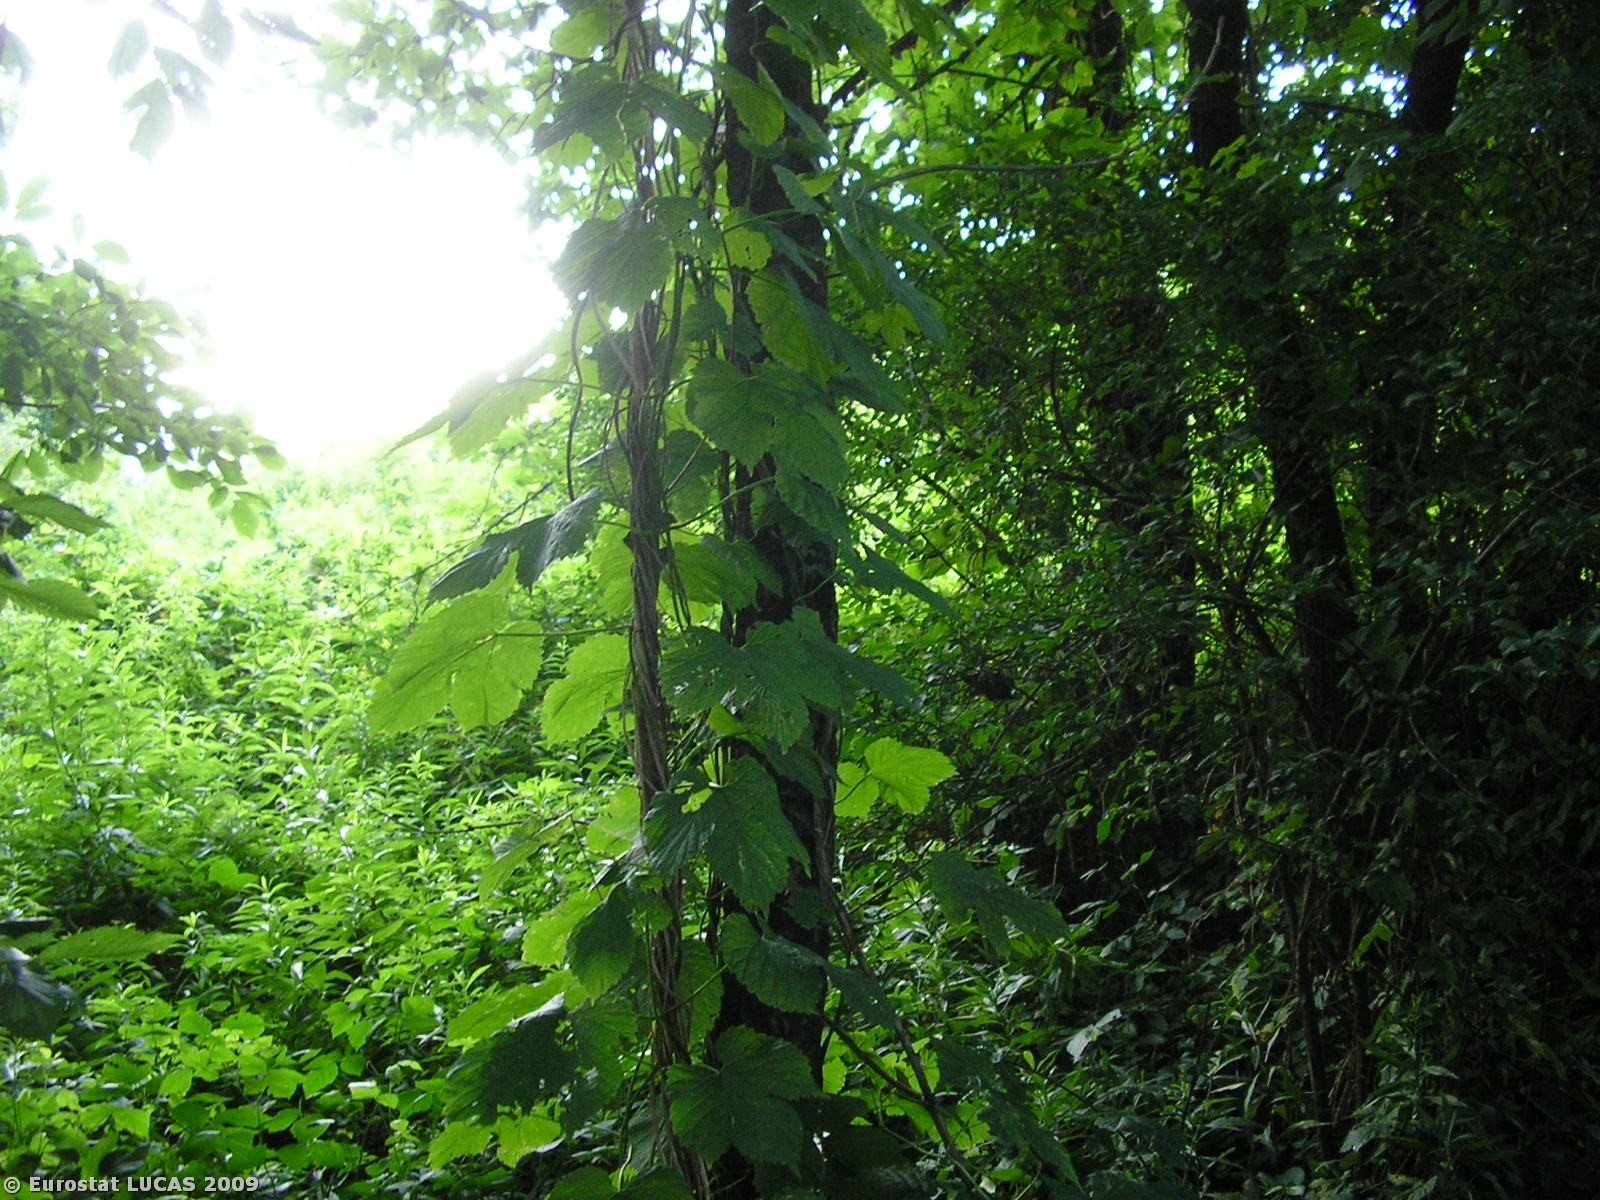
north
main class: Woodland
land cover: Broadleaved woodland
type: mesophytic deciduous forest
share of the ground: > 75 %
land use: Unused
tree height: > 5 m
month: July
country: PL
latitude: 50.2379
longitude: 20.7384
